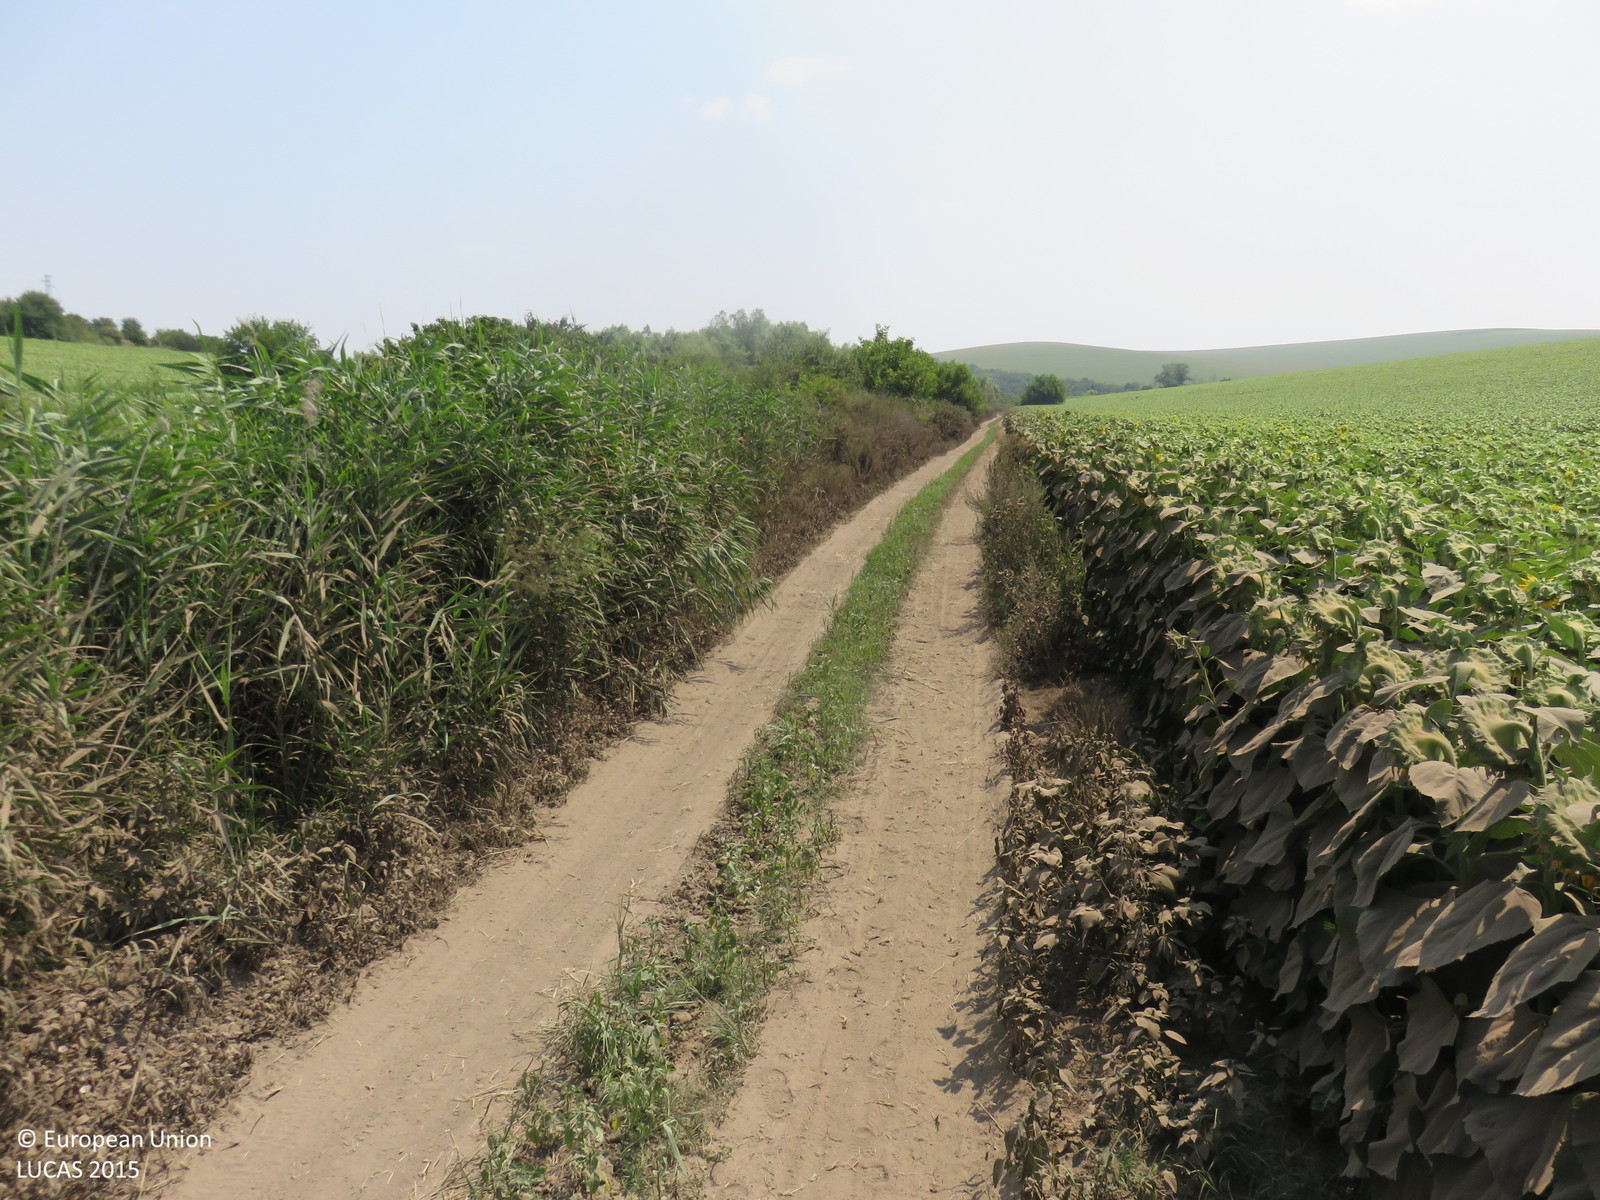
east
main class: Cropland
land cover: Sunflower
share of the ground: > 75 %
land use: Agriculture (excluding fallow land and kitchen gardens)
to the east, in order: Sunflower
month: July
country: BG
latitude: 43.5441
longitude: 25.1366
